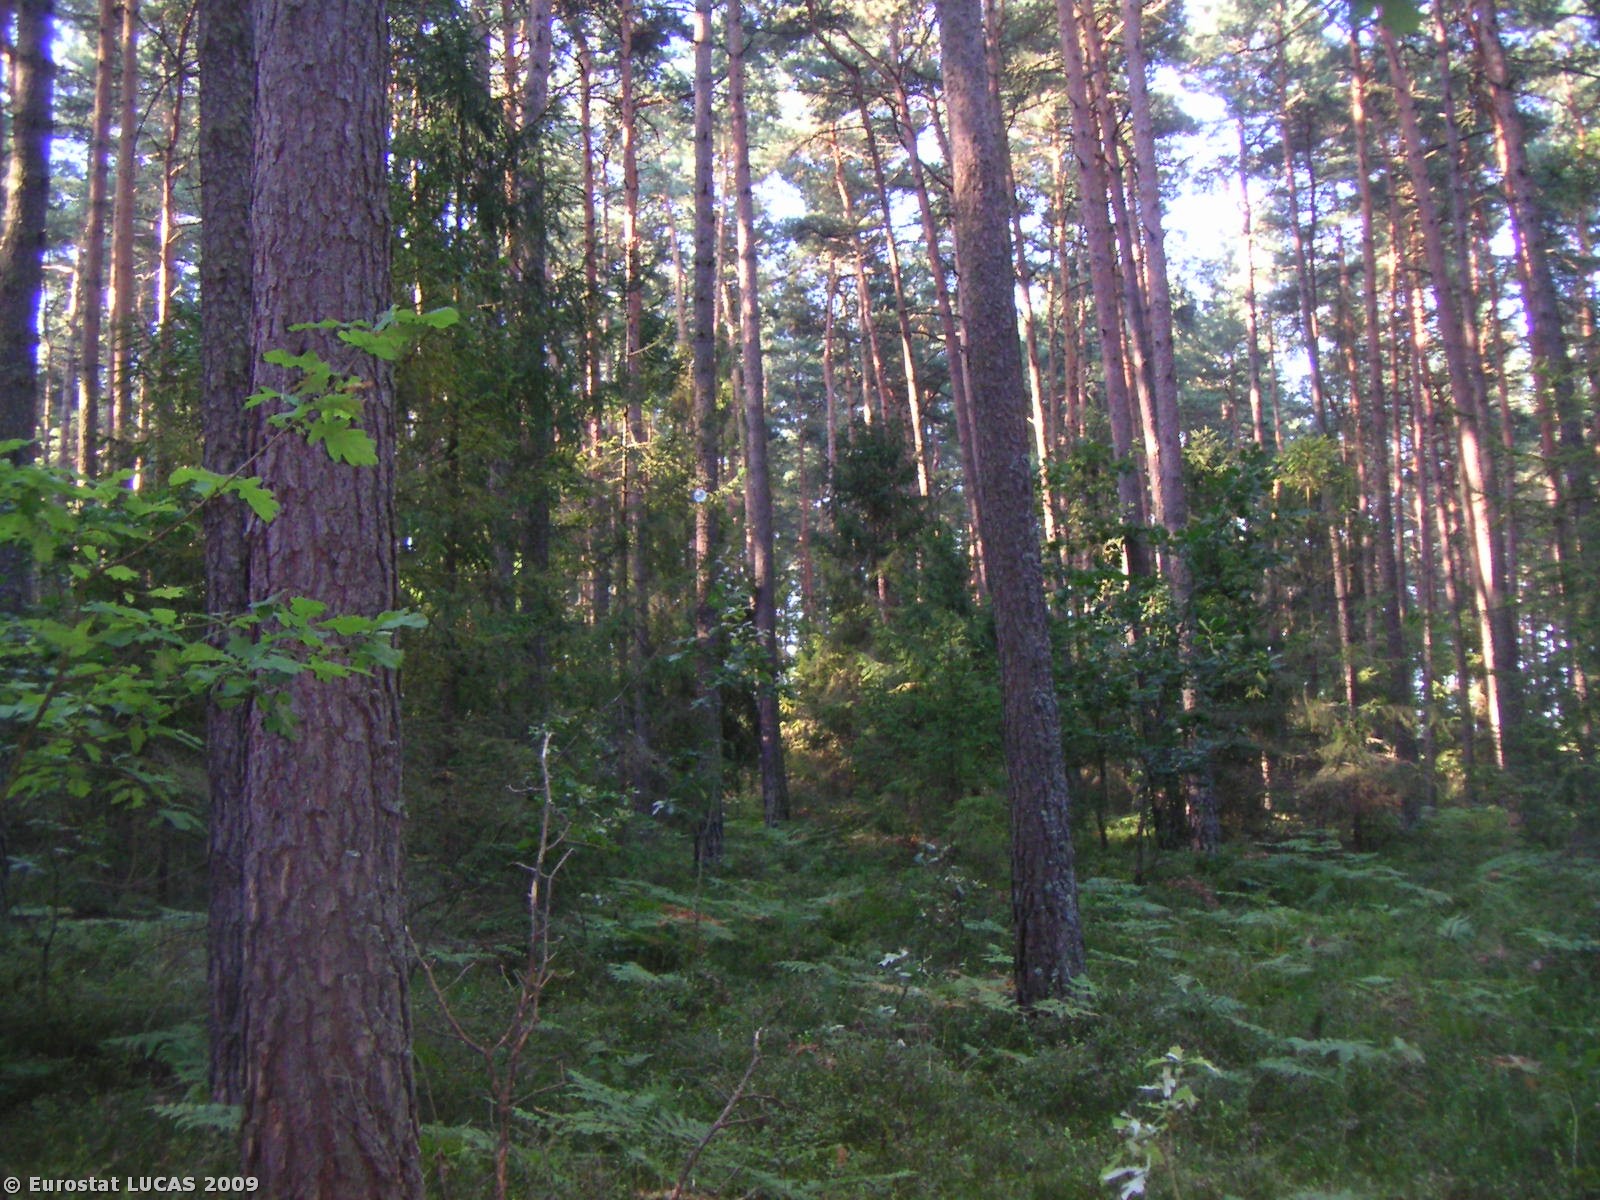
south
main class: Woodland
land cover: Coniferous woodland
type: hemiboreal forest and nemoral coniferous forest and mixed broadleaved-coniferous forest
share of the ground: > 75 %
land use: Forestry
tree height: > 5 m
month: August
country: PL
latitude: 50.6170
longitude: 18.8554
